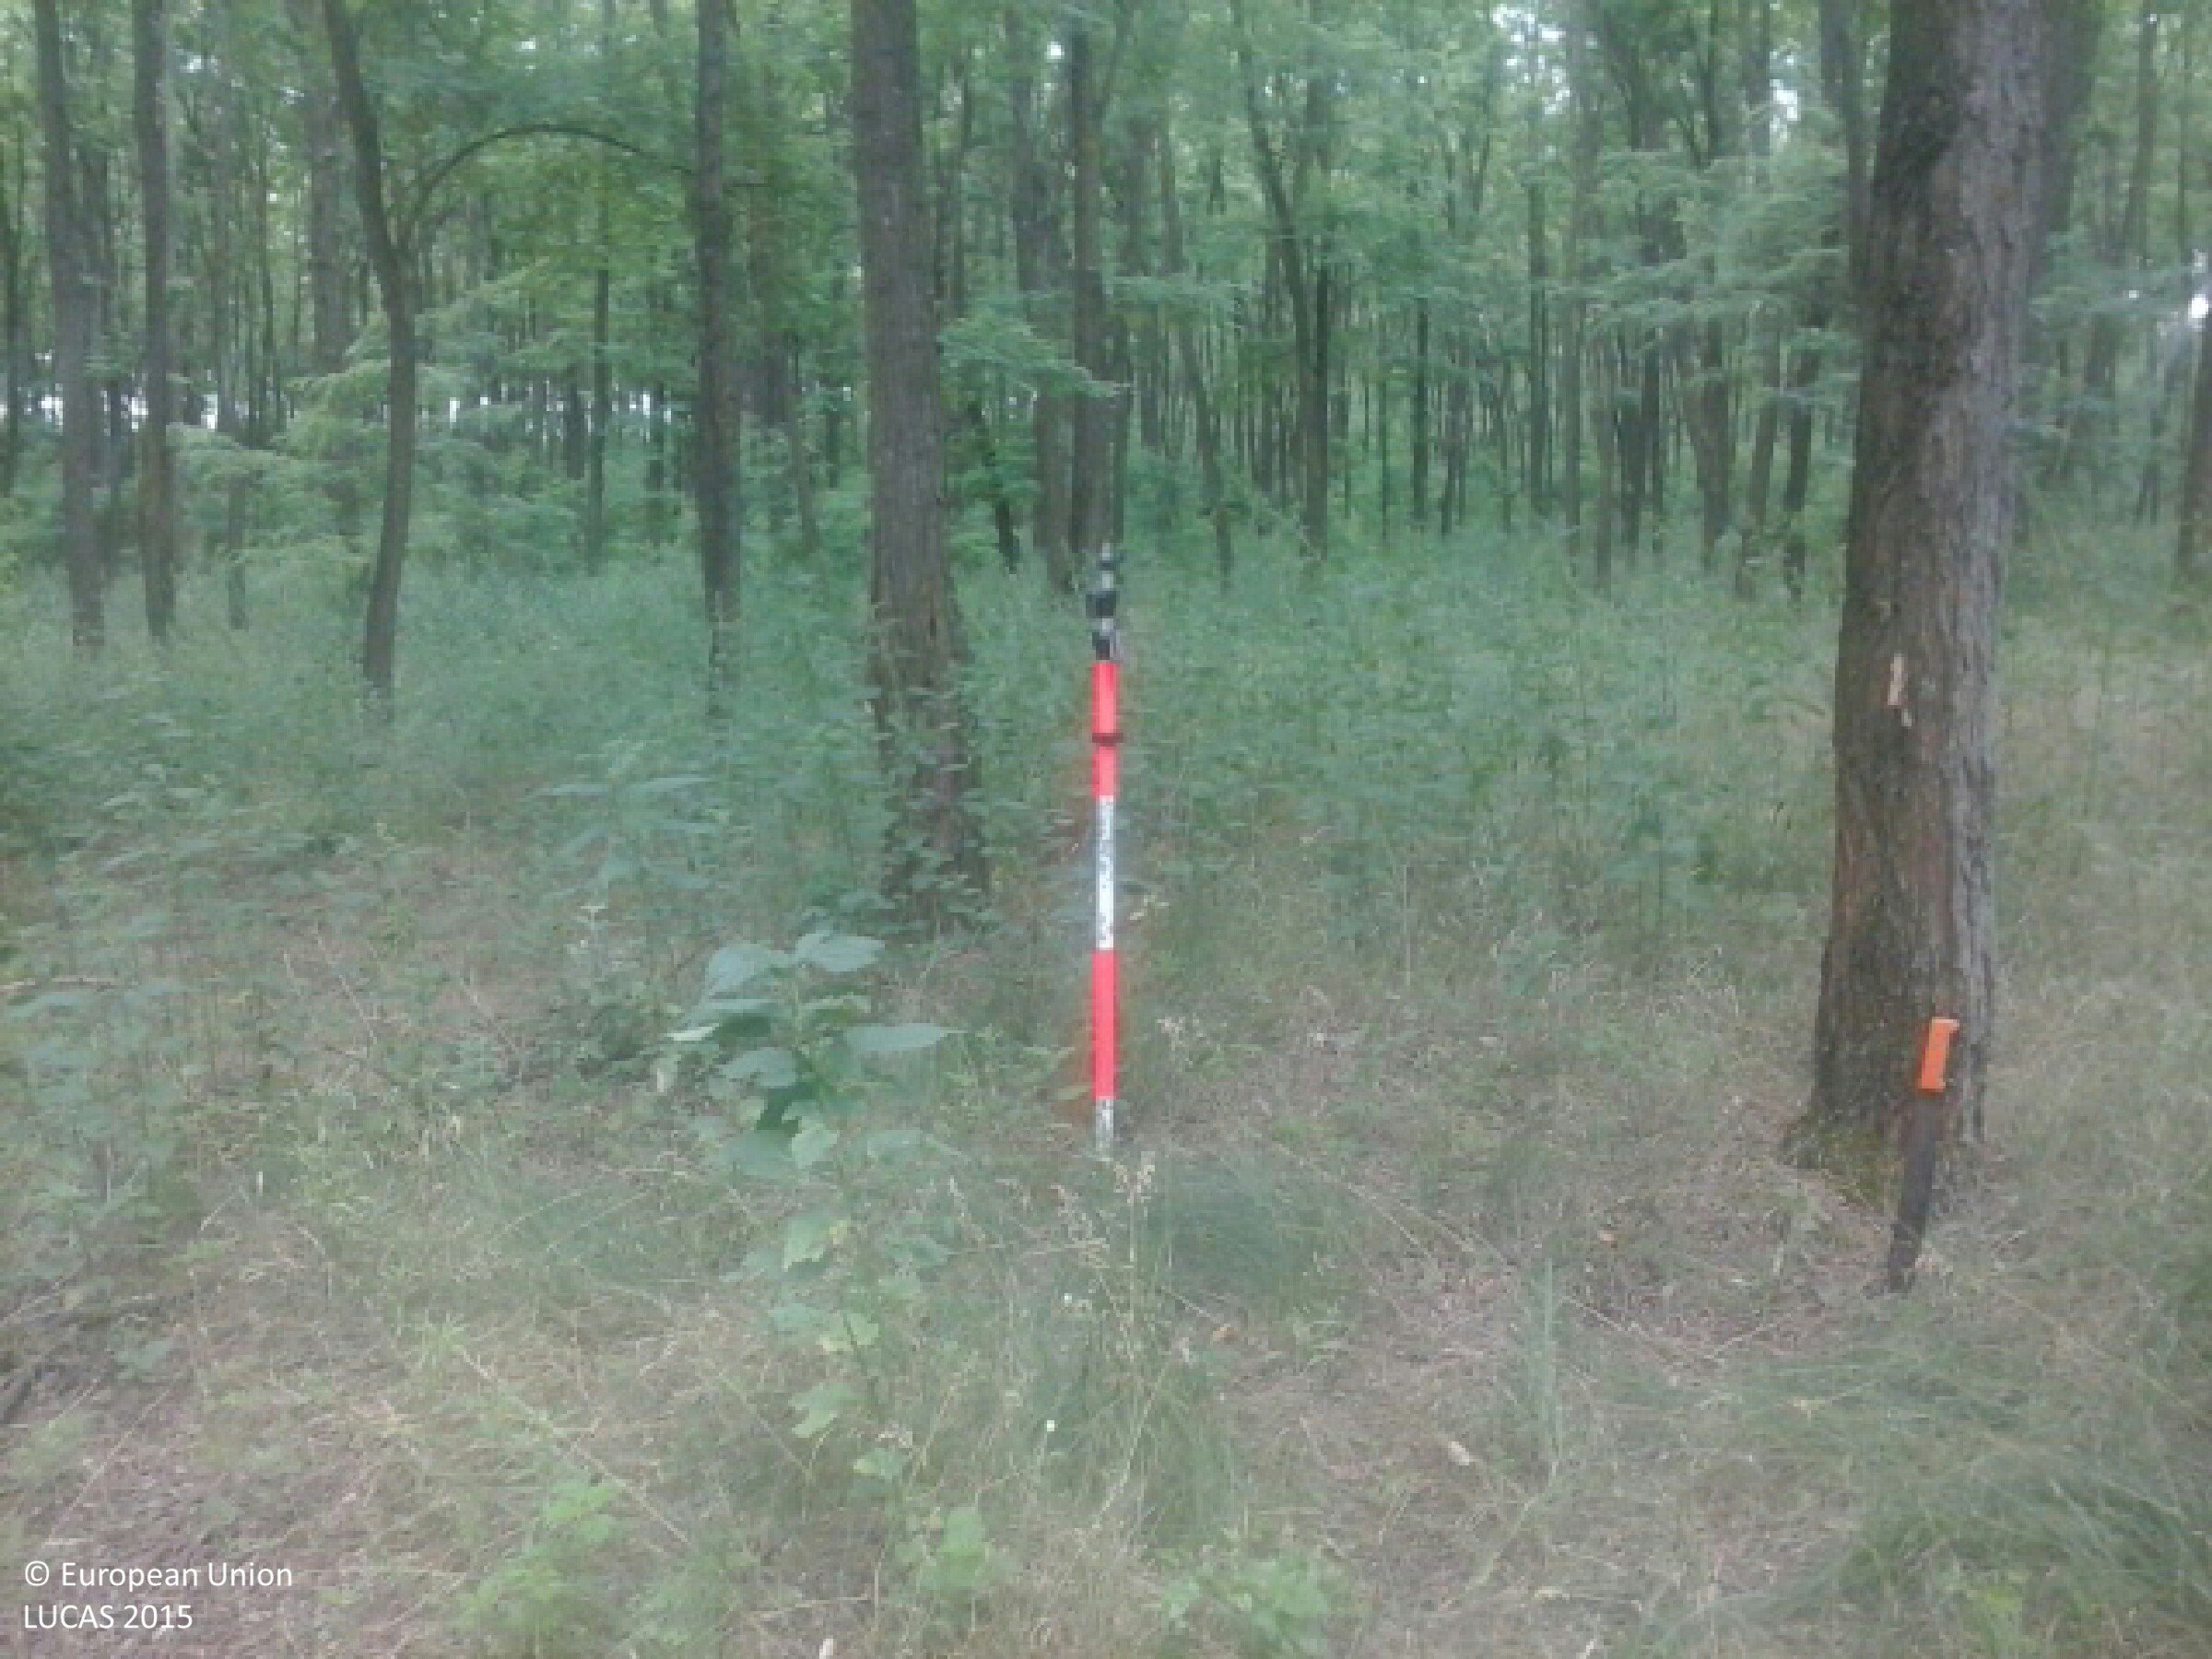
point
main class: Woodland
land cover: Broadleaved woodland
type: mesophytic deciduous forest
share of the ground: > 75 %
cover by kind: broadleaved forest trees 95 %, herbaceous plants 5 %
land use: Forestry
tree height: > 5 m
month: June
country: HU
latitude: 47.9465
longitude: 22.1712
